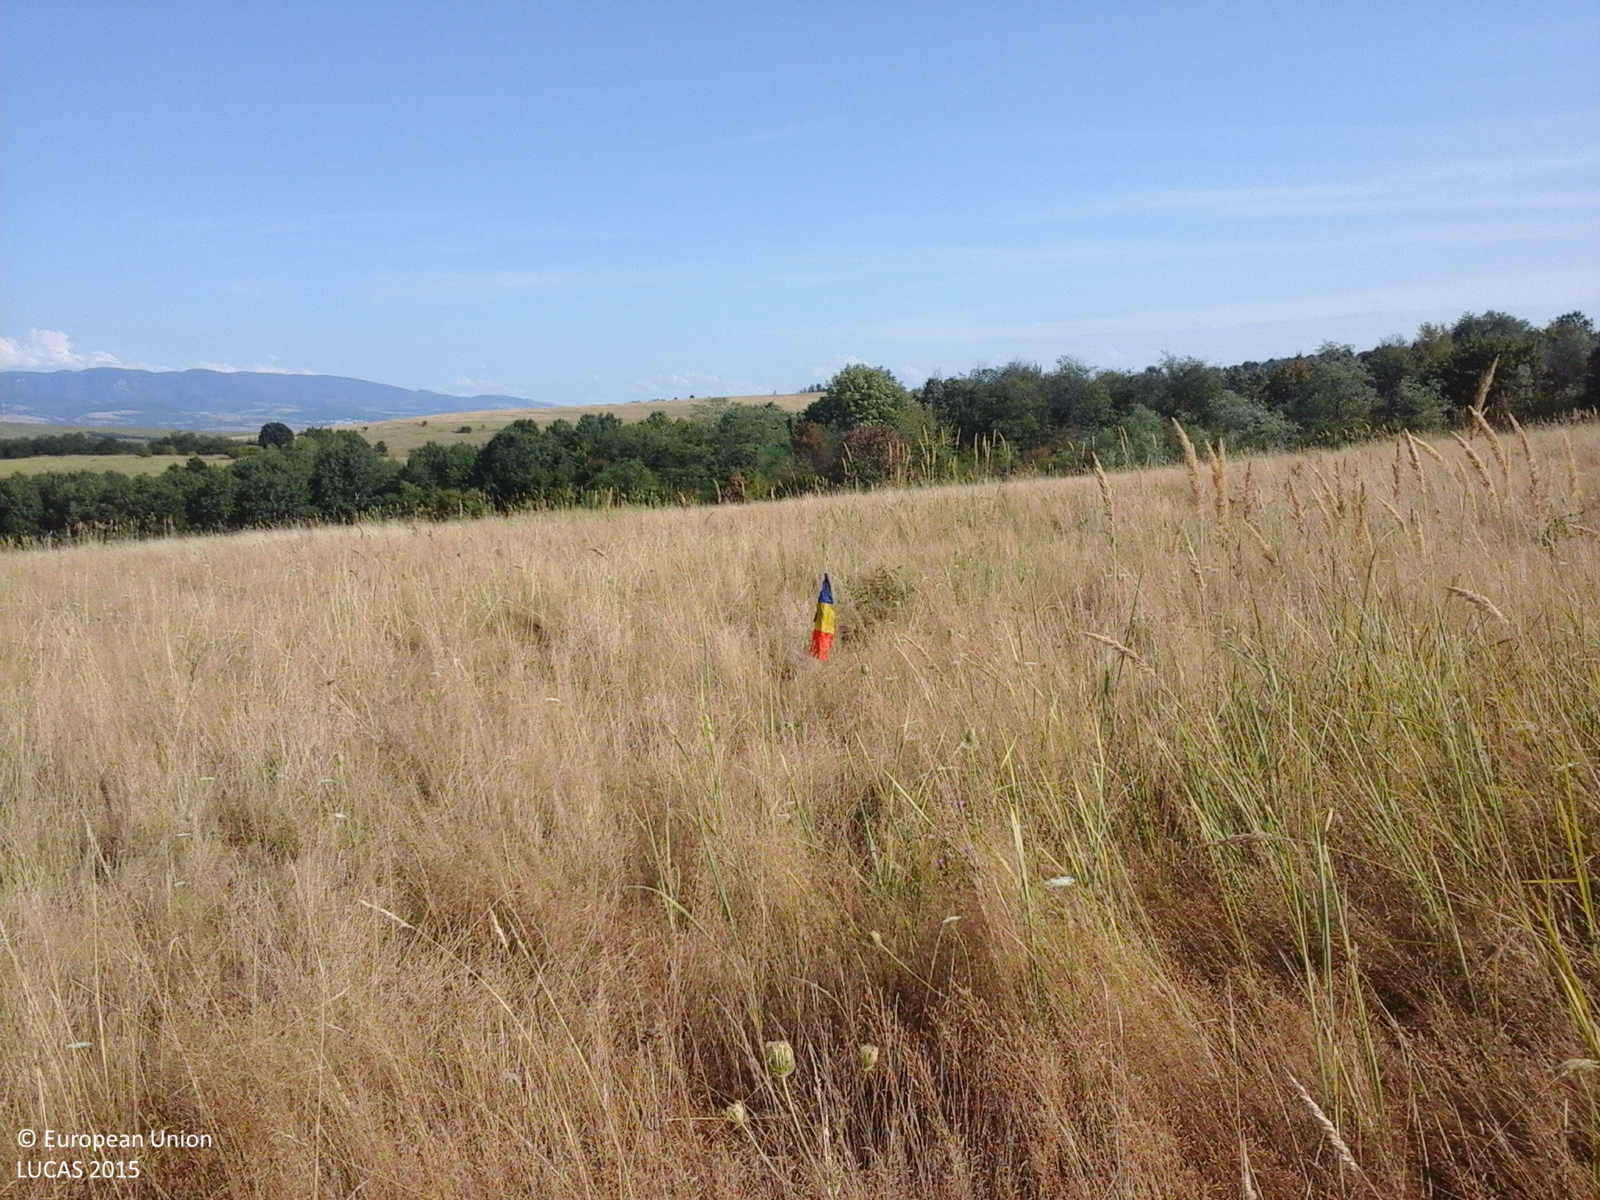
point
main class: Grassland
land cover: Grassland without tree/shrub cover
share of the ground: > 75 %
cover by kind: herbaceous plants 100 %
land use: Agriculture (excluding fallow land and kitchen gardens)
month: August
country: RO
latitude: 45.1423
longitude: 21.5398
